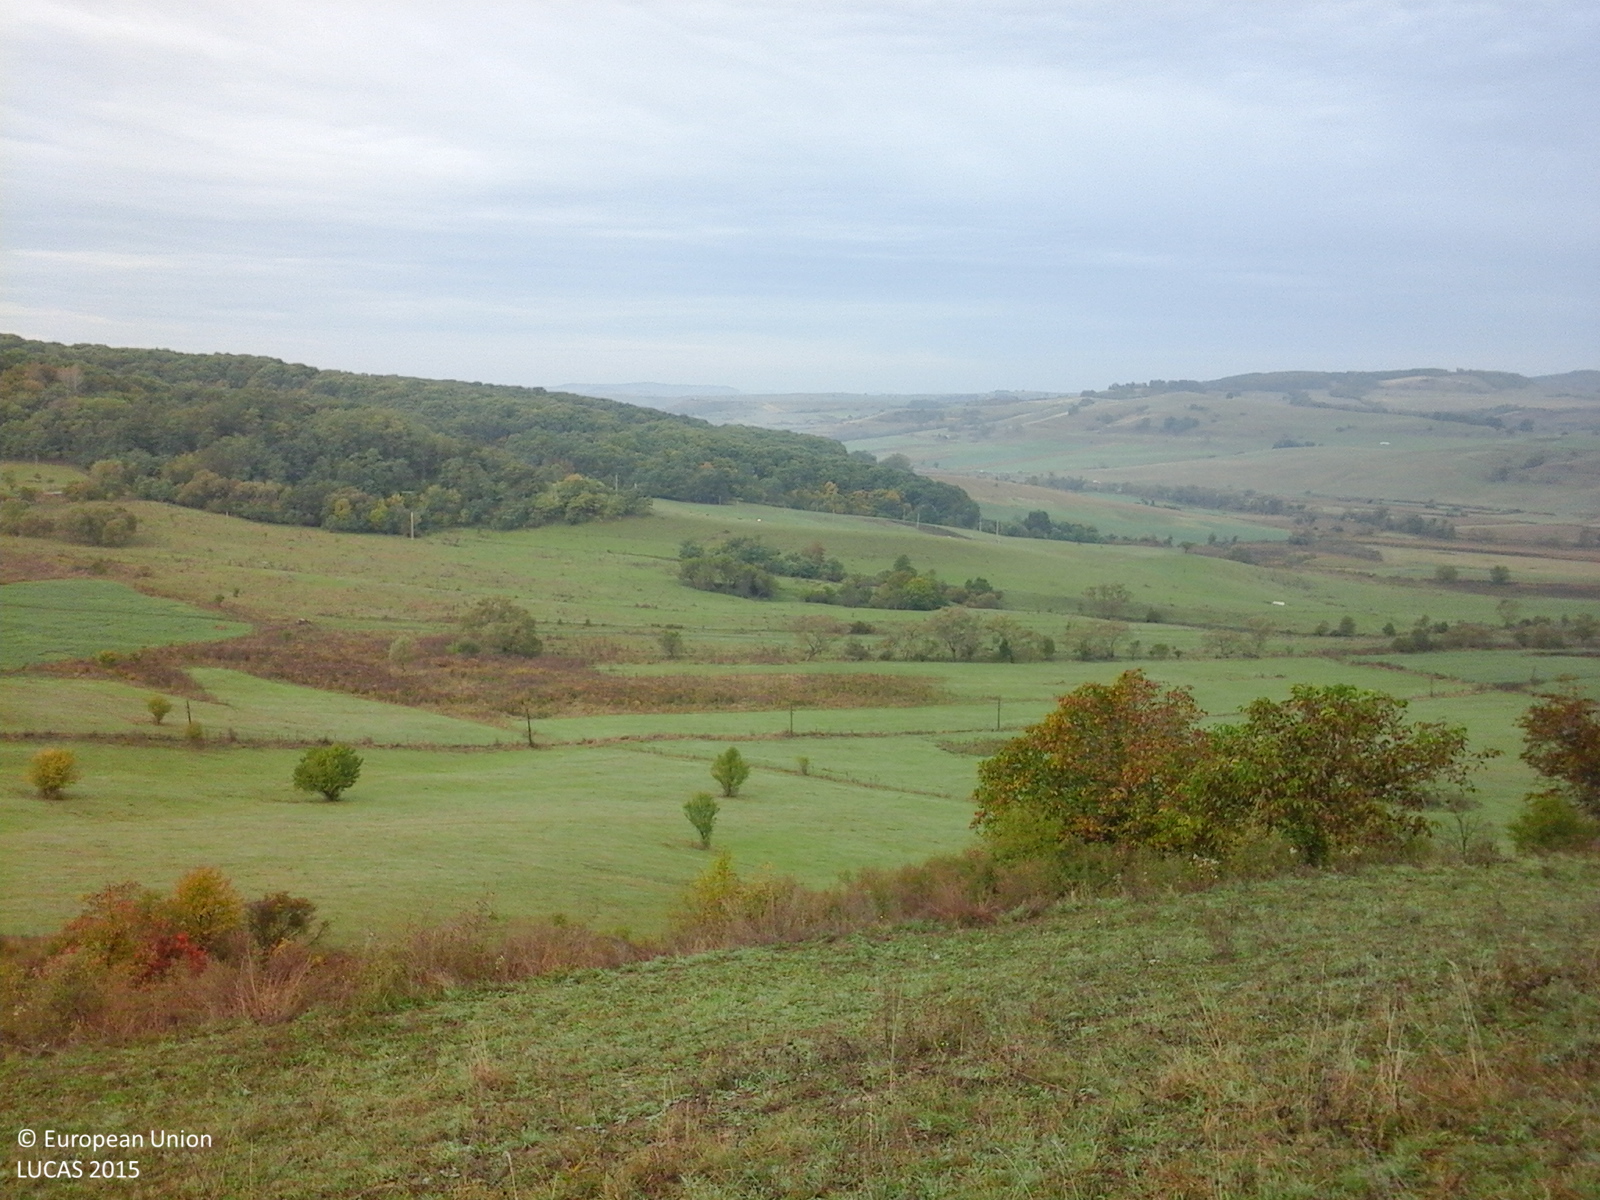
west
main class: Grassland
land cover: Grassland without tree/shrub cover
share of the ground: > 75 %
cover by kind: herbaceous plants 100 %
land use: Agriculture (excluding fallow land and kitchen gardens)
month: October
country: RO
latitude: 45.9890
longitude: 24.6881
